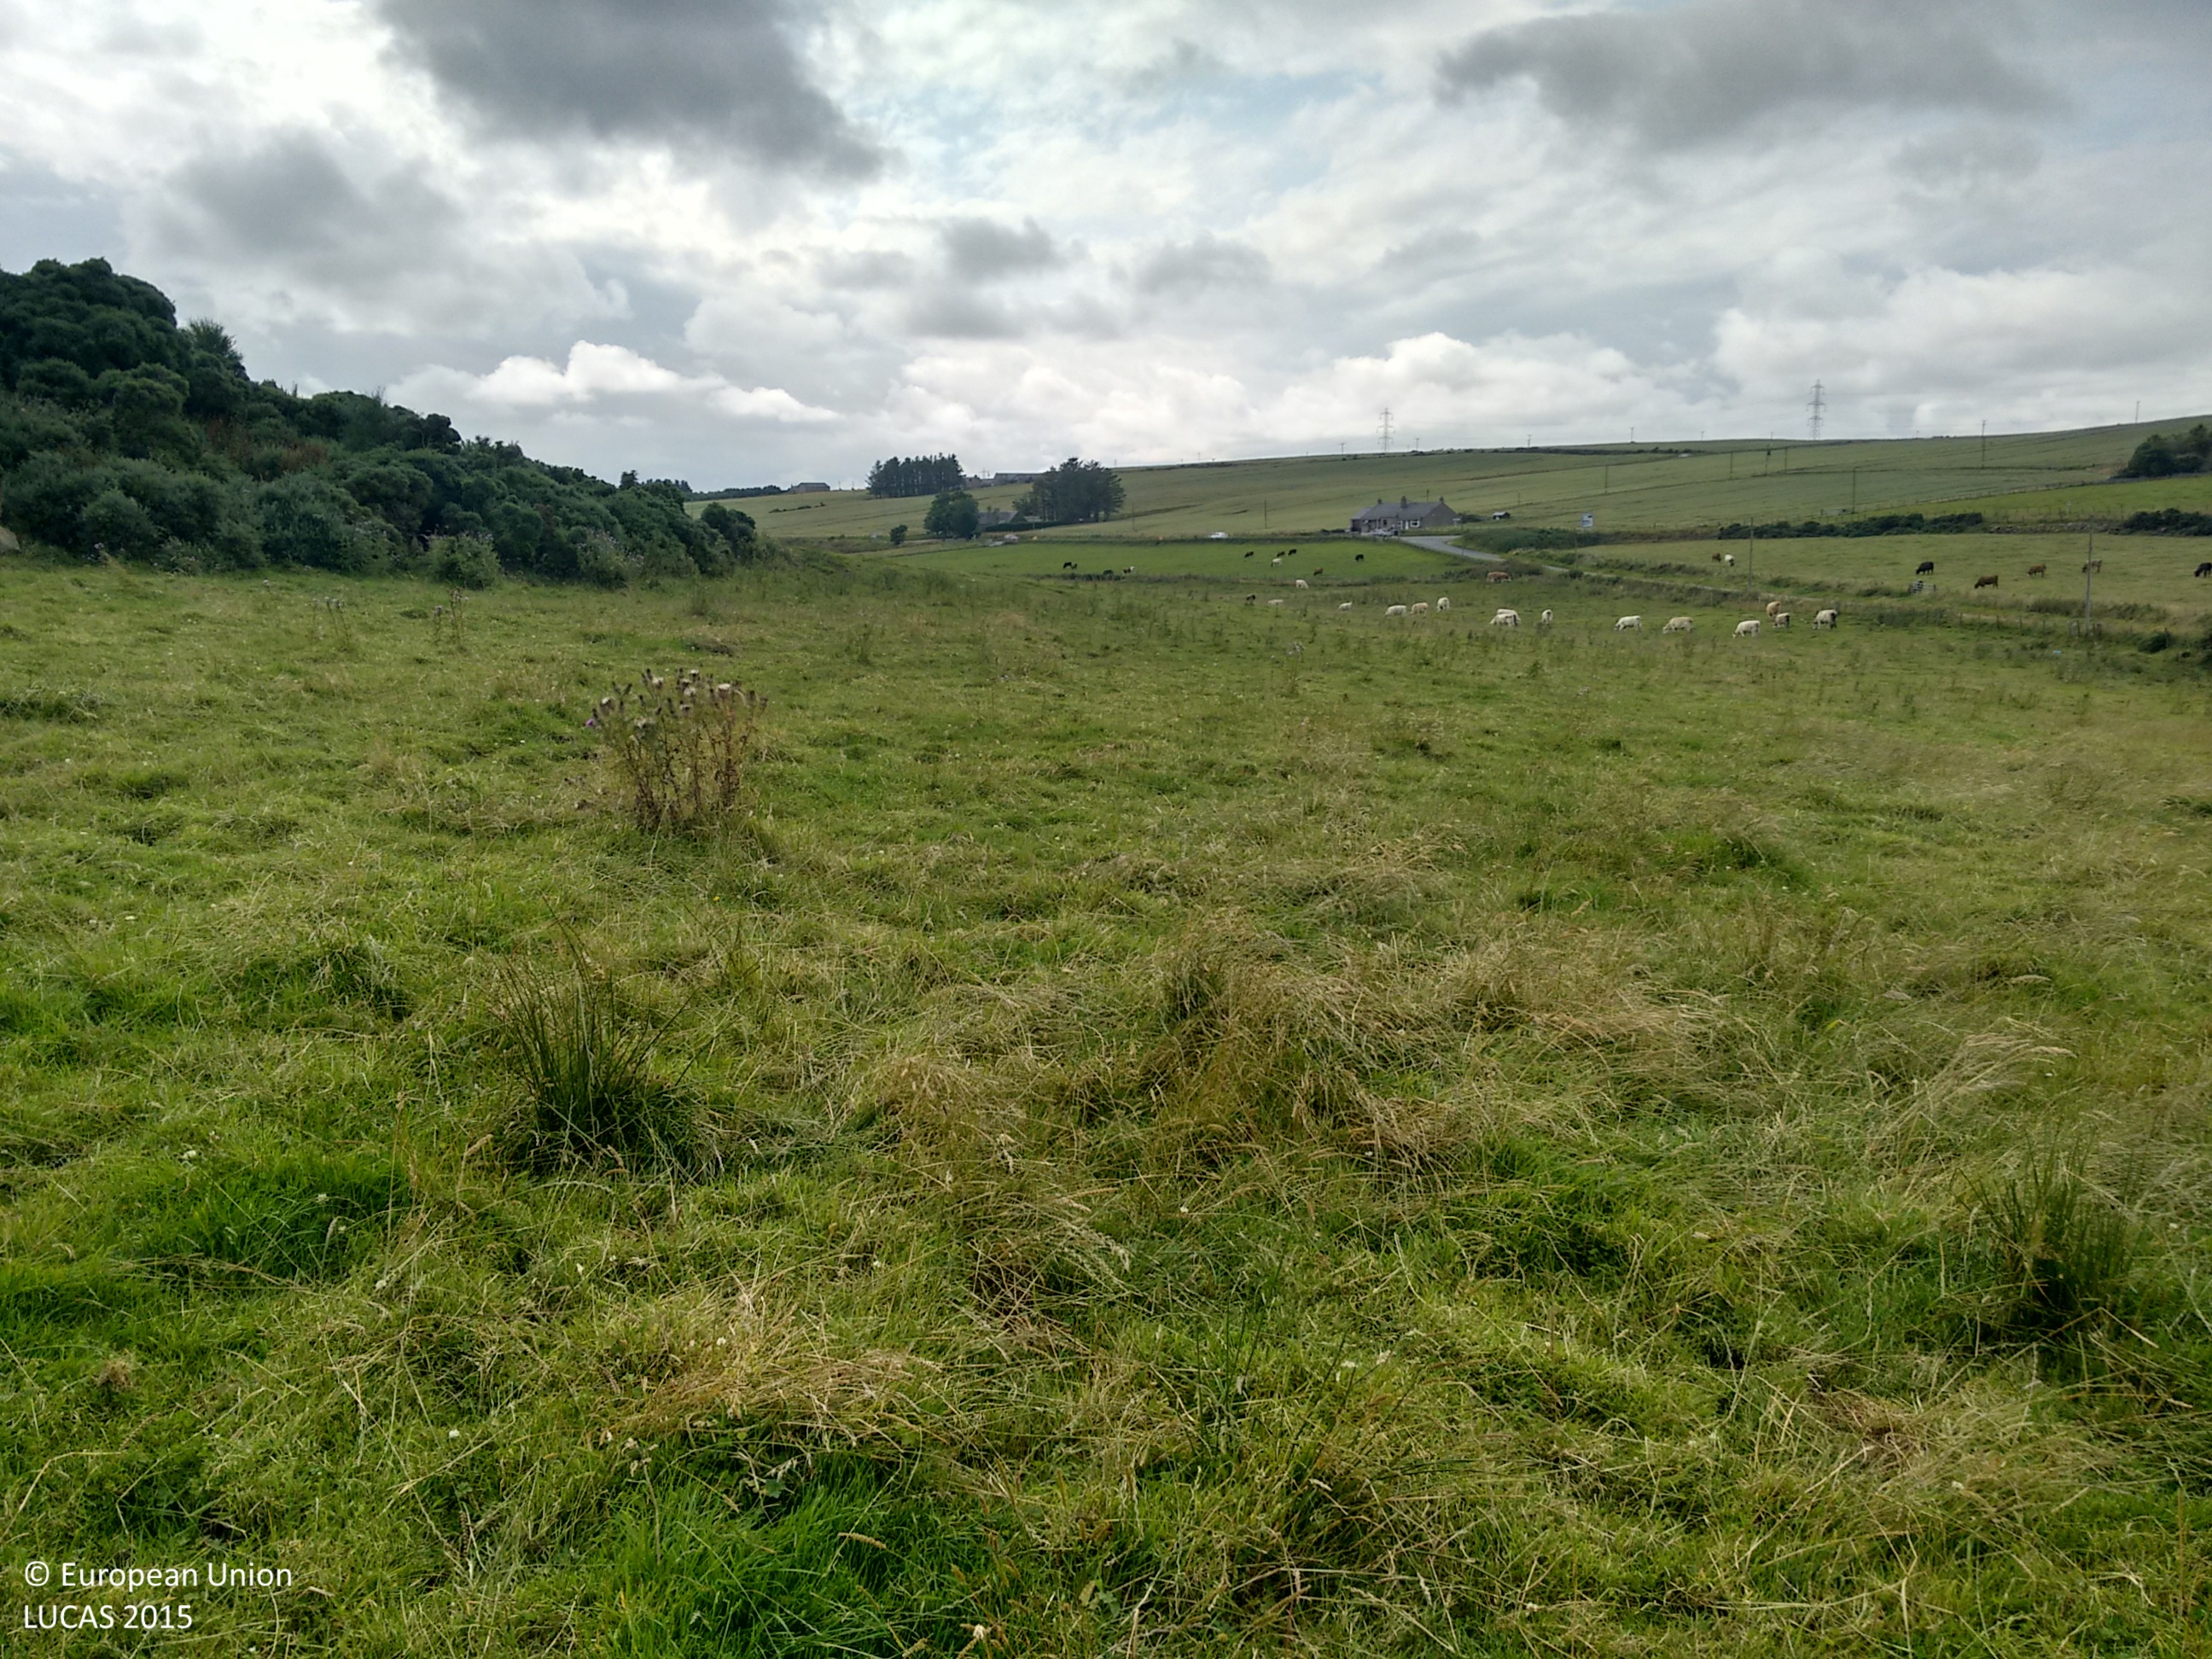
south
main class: Grassland
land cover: Grassland without tree/shrub cover
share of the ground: > 75 %
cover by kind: herbaceous plants 100 %
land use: Agriculture (excluding fallow land and kitchen gardens)
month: August
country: GB
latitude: 57.2663
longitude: -2.1360
